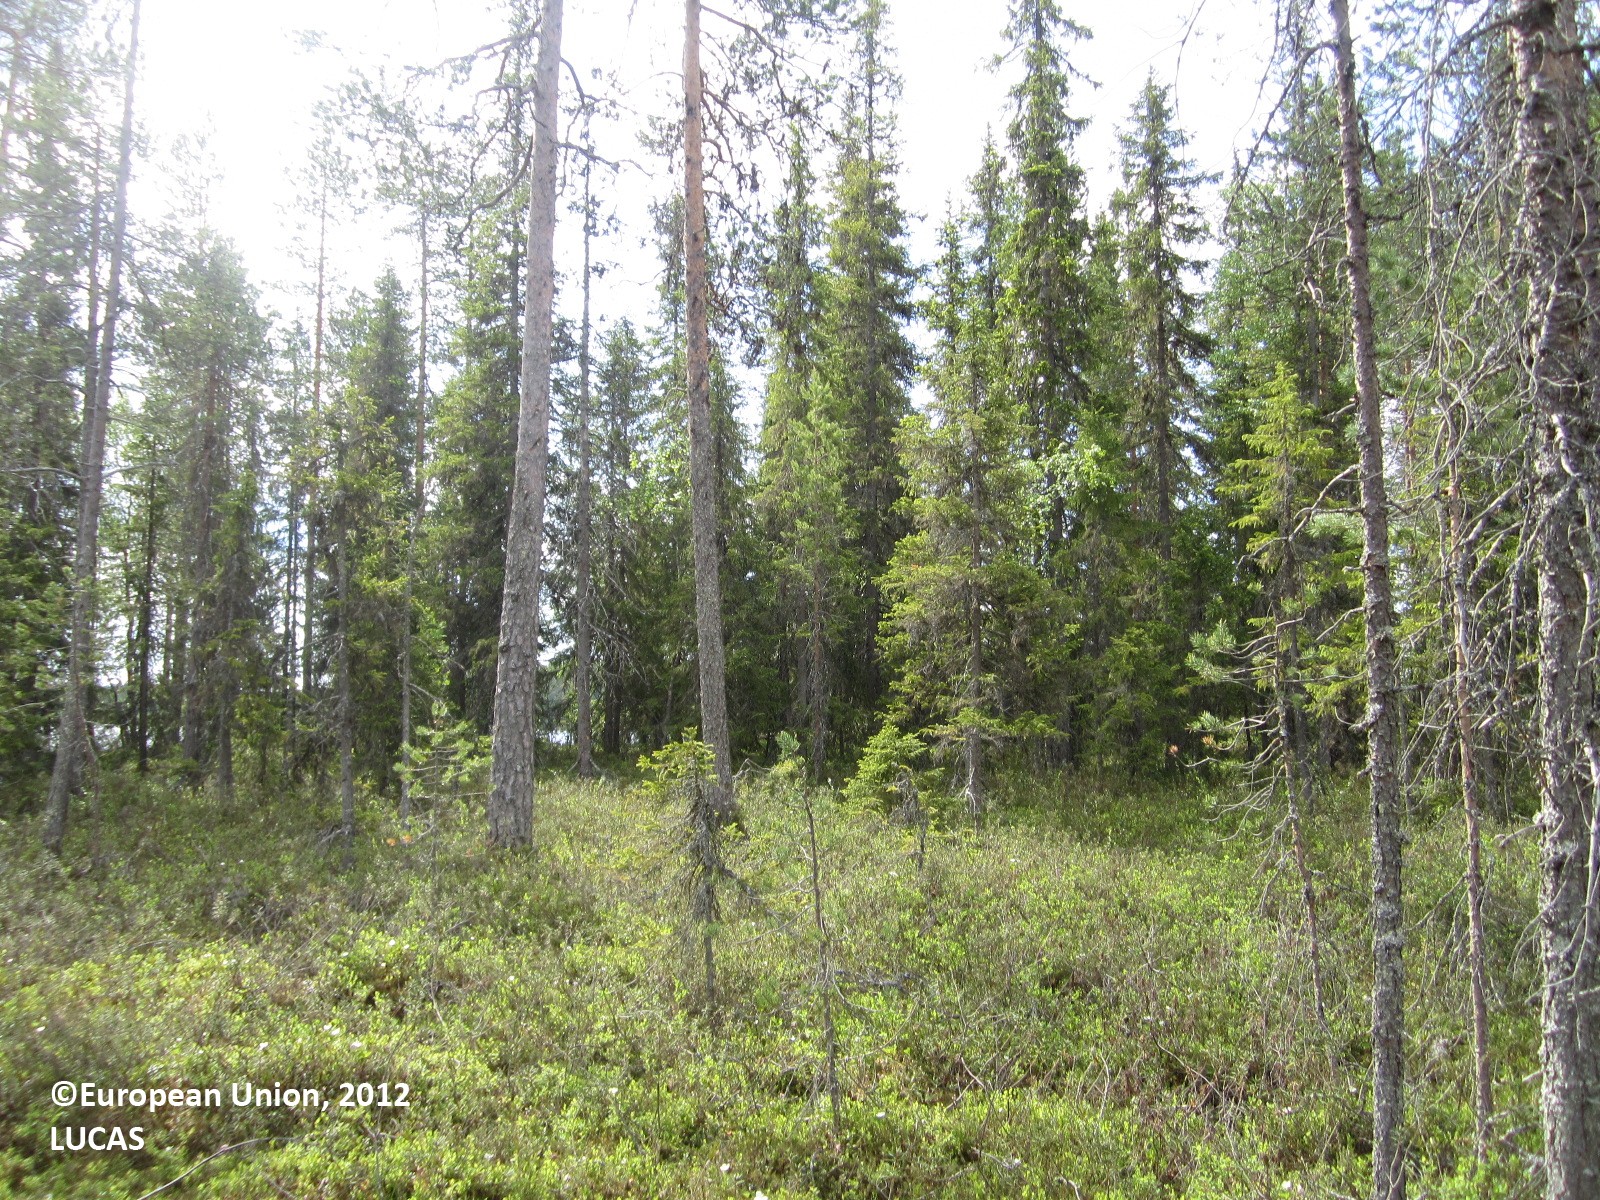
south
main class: Woodland
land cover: Pine dominated coniferous woodland
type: boreal forest
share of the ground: 25 - 50 %
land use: Forestry
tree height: > 5 m
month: June
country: FI
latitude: 64.9410
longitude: 29.2629
